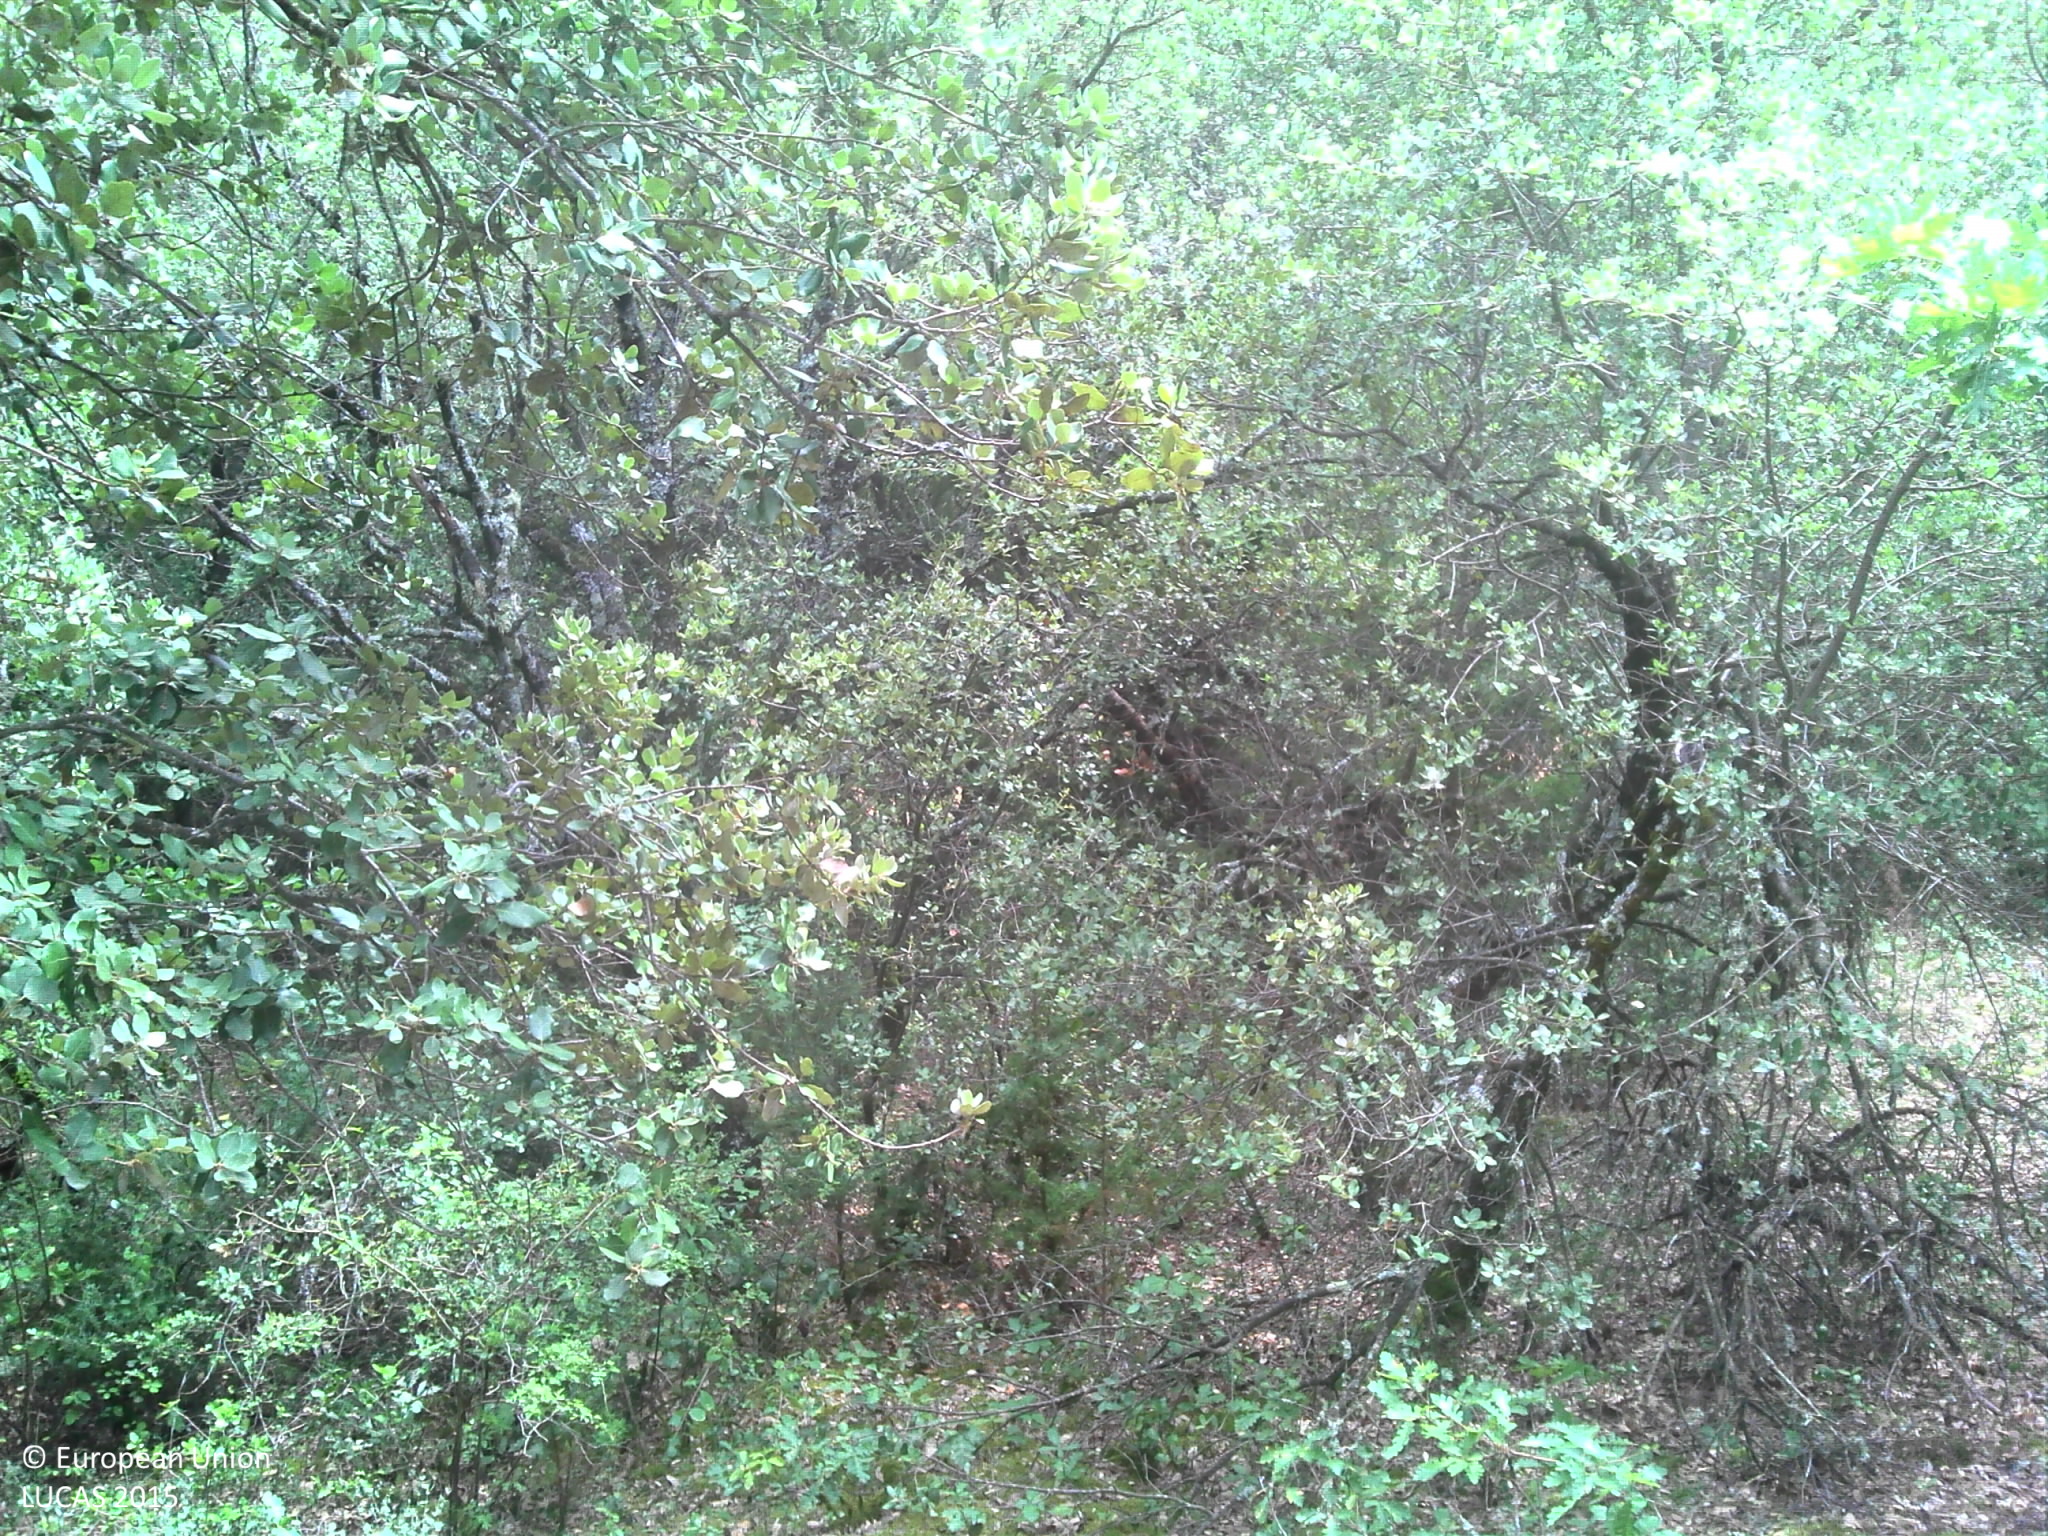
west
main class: Woodland
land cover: Broadleaved woodland
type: thermophilous deciduous forest
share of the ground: 50 - 75 %
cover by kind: broadleaved forest trees 60 %, herbaceous plants 25 %, unconsolidated bare surface 15 %
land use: Semi-natural and natural areas not in use
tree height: > 5 m
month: July
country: FR
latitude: 44.0046
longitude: 5.6057
